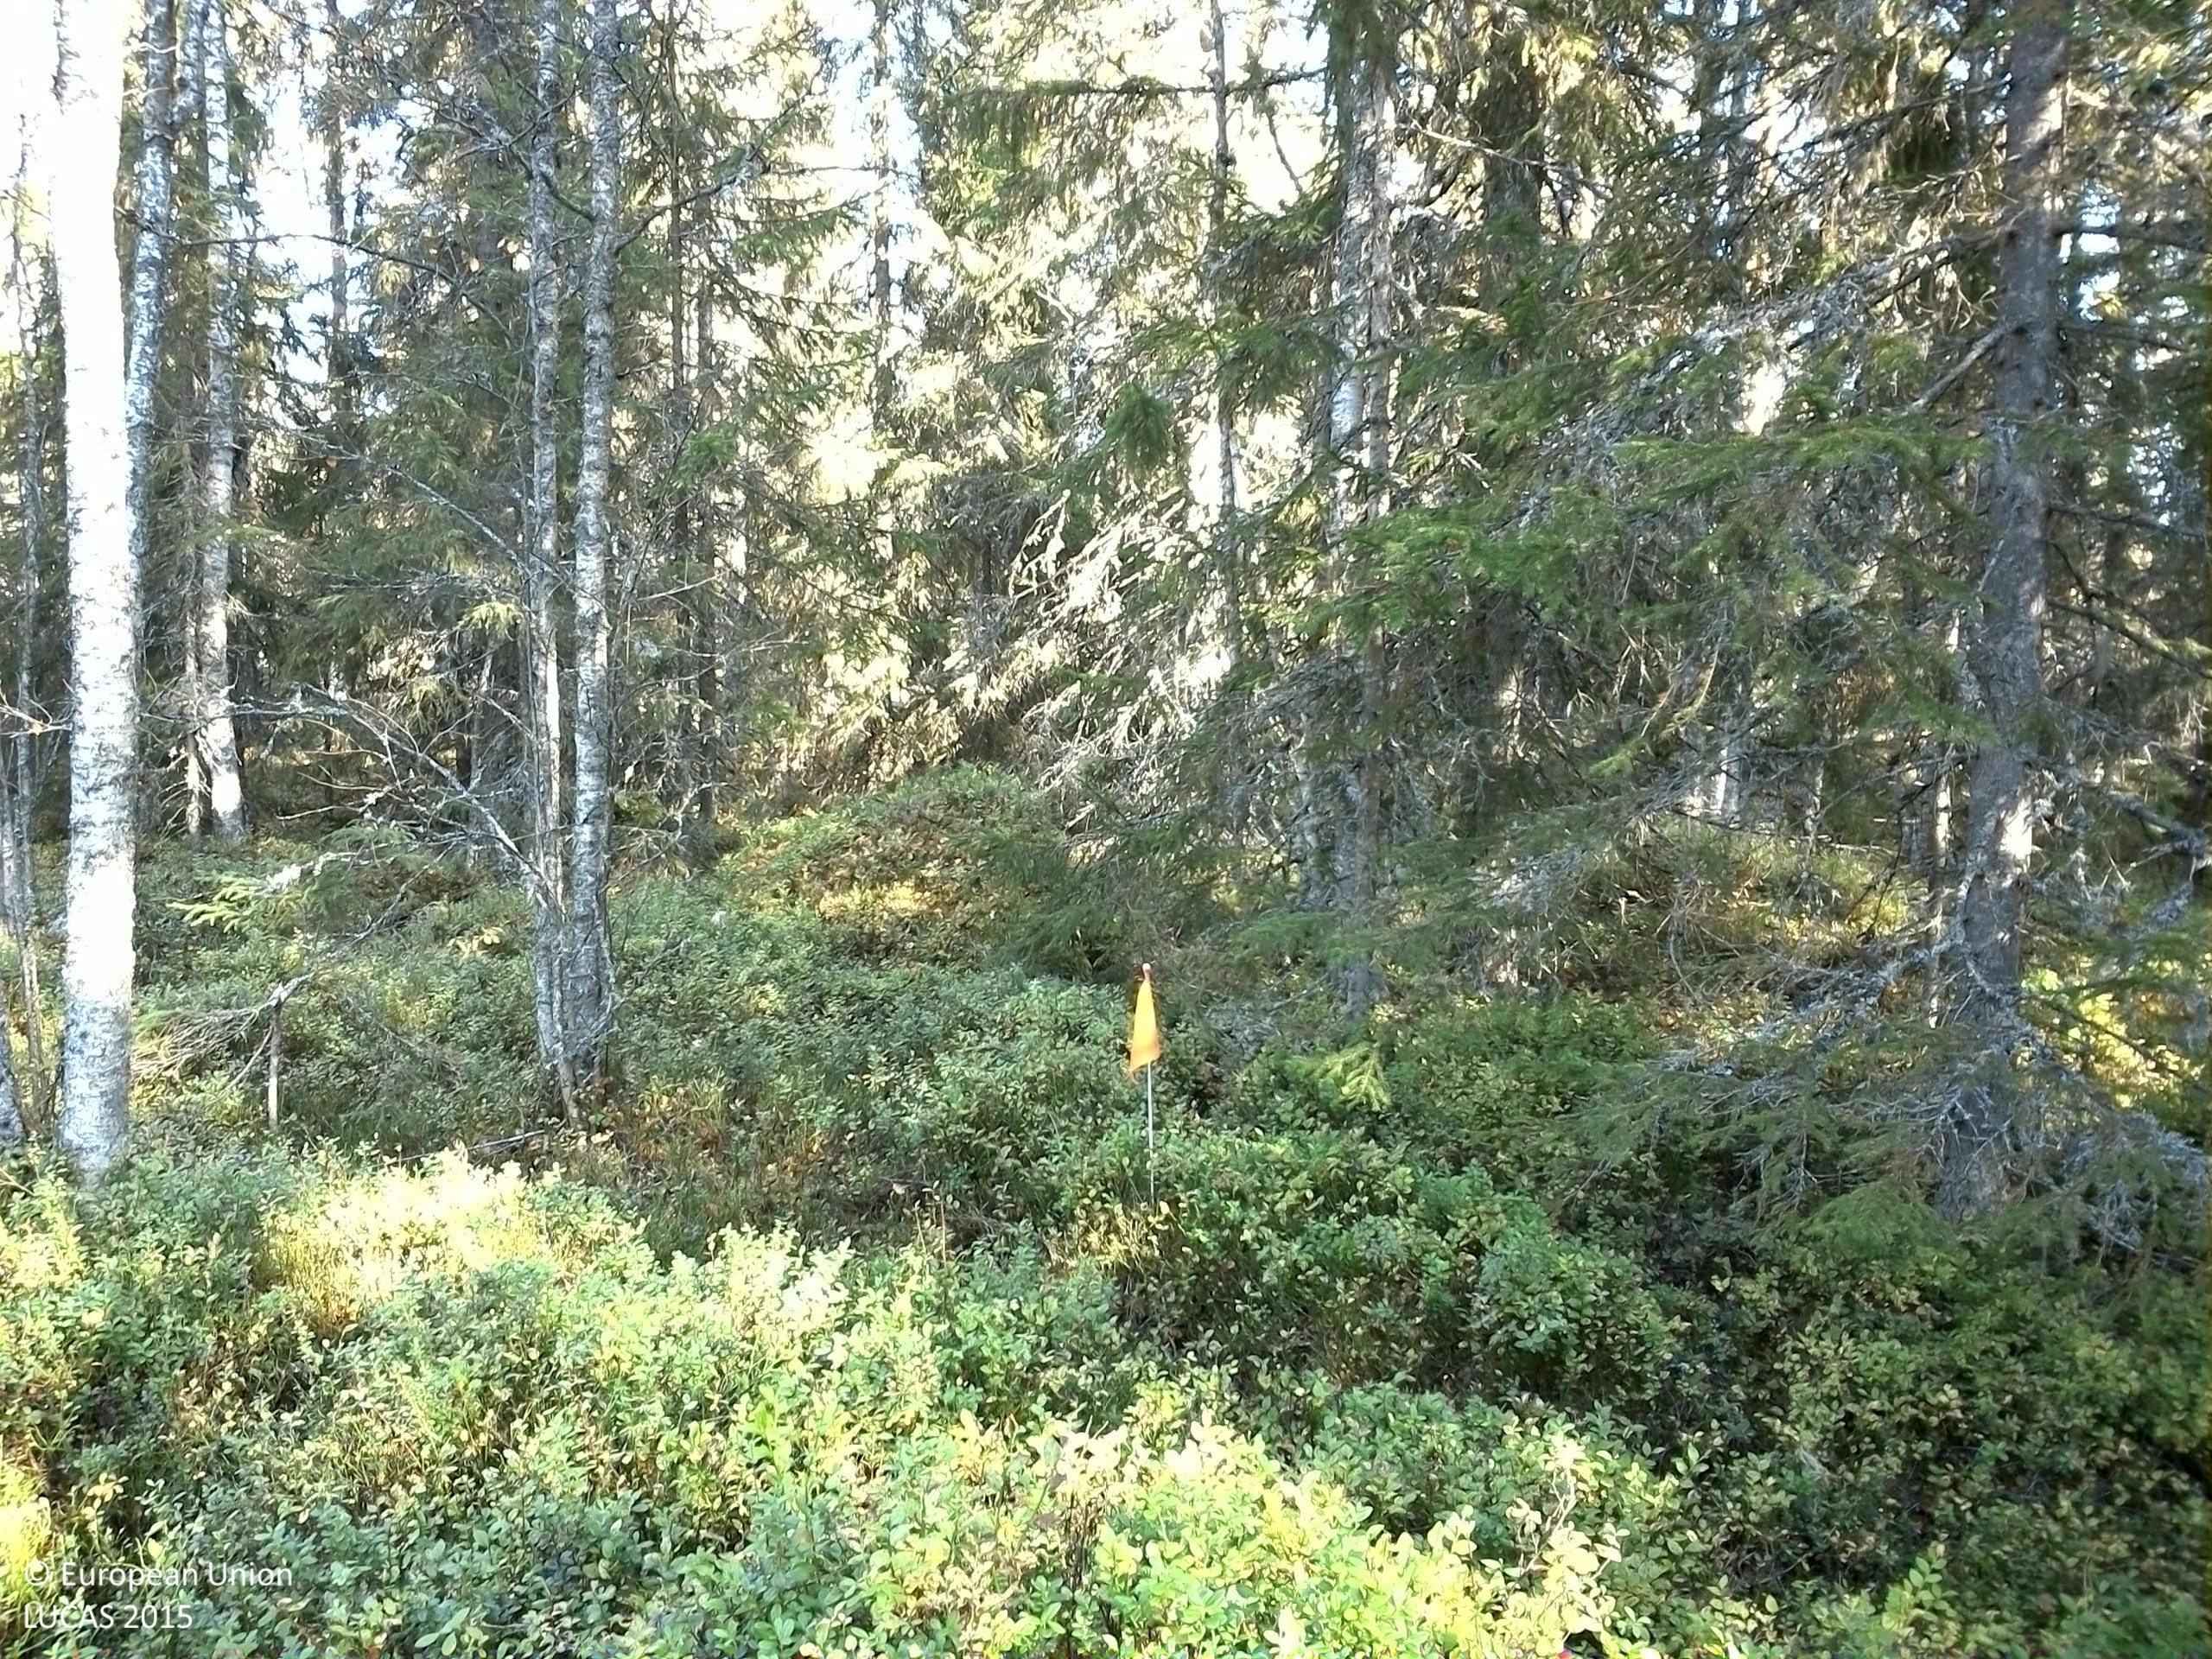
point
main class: Woodland
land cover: Spruce dominated mixed woodland
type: boreal forest
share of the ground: 50 - 75 %
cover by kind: coniferous forest trees 50 %, shrubs 25 %, broadleaved forest trees 20 %, lichens and mosses 5 %
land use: Forestry
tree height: > 5 m
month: October
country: SE
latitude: 61.2366
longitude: 15.2945
